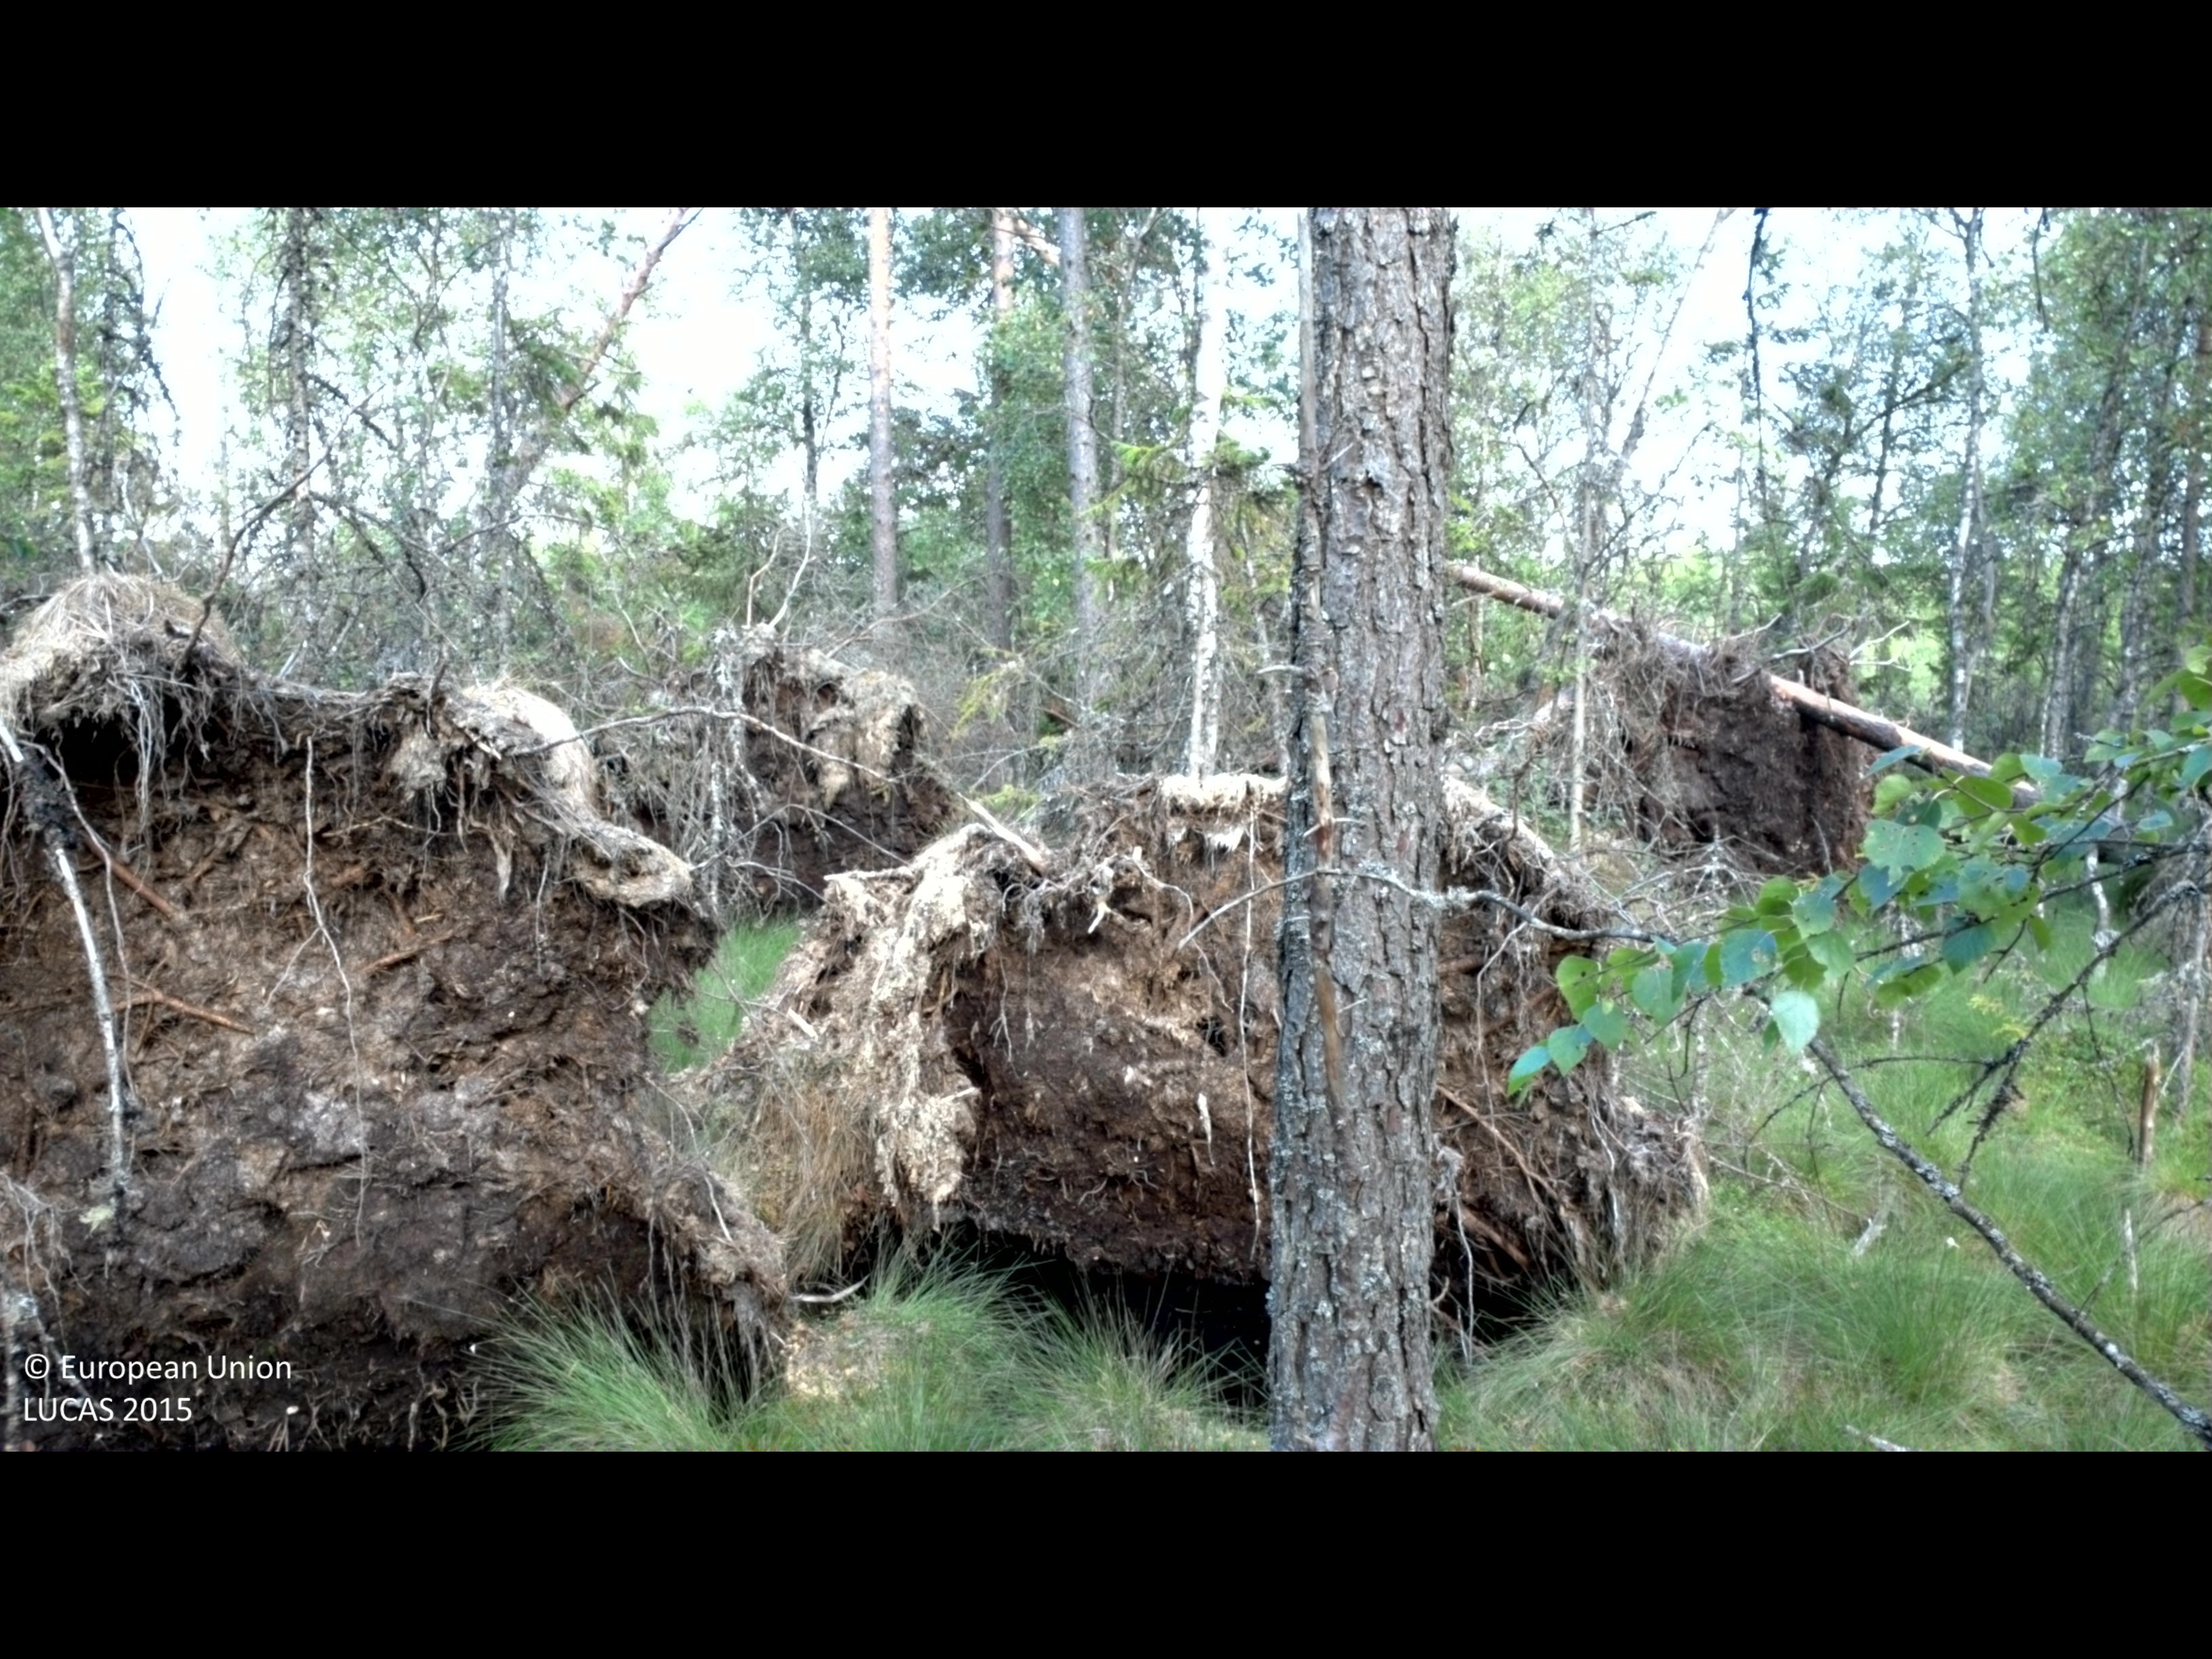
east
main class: Woodland
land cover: Pine dominated mixed woodland
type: mire and swamp forests
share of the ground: 50 - 75 %
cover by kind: broadleaved forest trees 35 %, herbaceous plants 35 %, coniferous forest trees 30 %
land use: Semi-natural and natural areas not in use
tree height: > 5 m
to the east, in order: Pine dominated mixed woodland; Spruce dominated mixed woodland; Broadleaved woodland; Spruce dominated mixed woodland; Broadleaved woodland; Spruce dominated mixed woodland
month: August
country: SE
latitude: 56.7355
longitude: 14.0671
